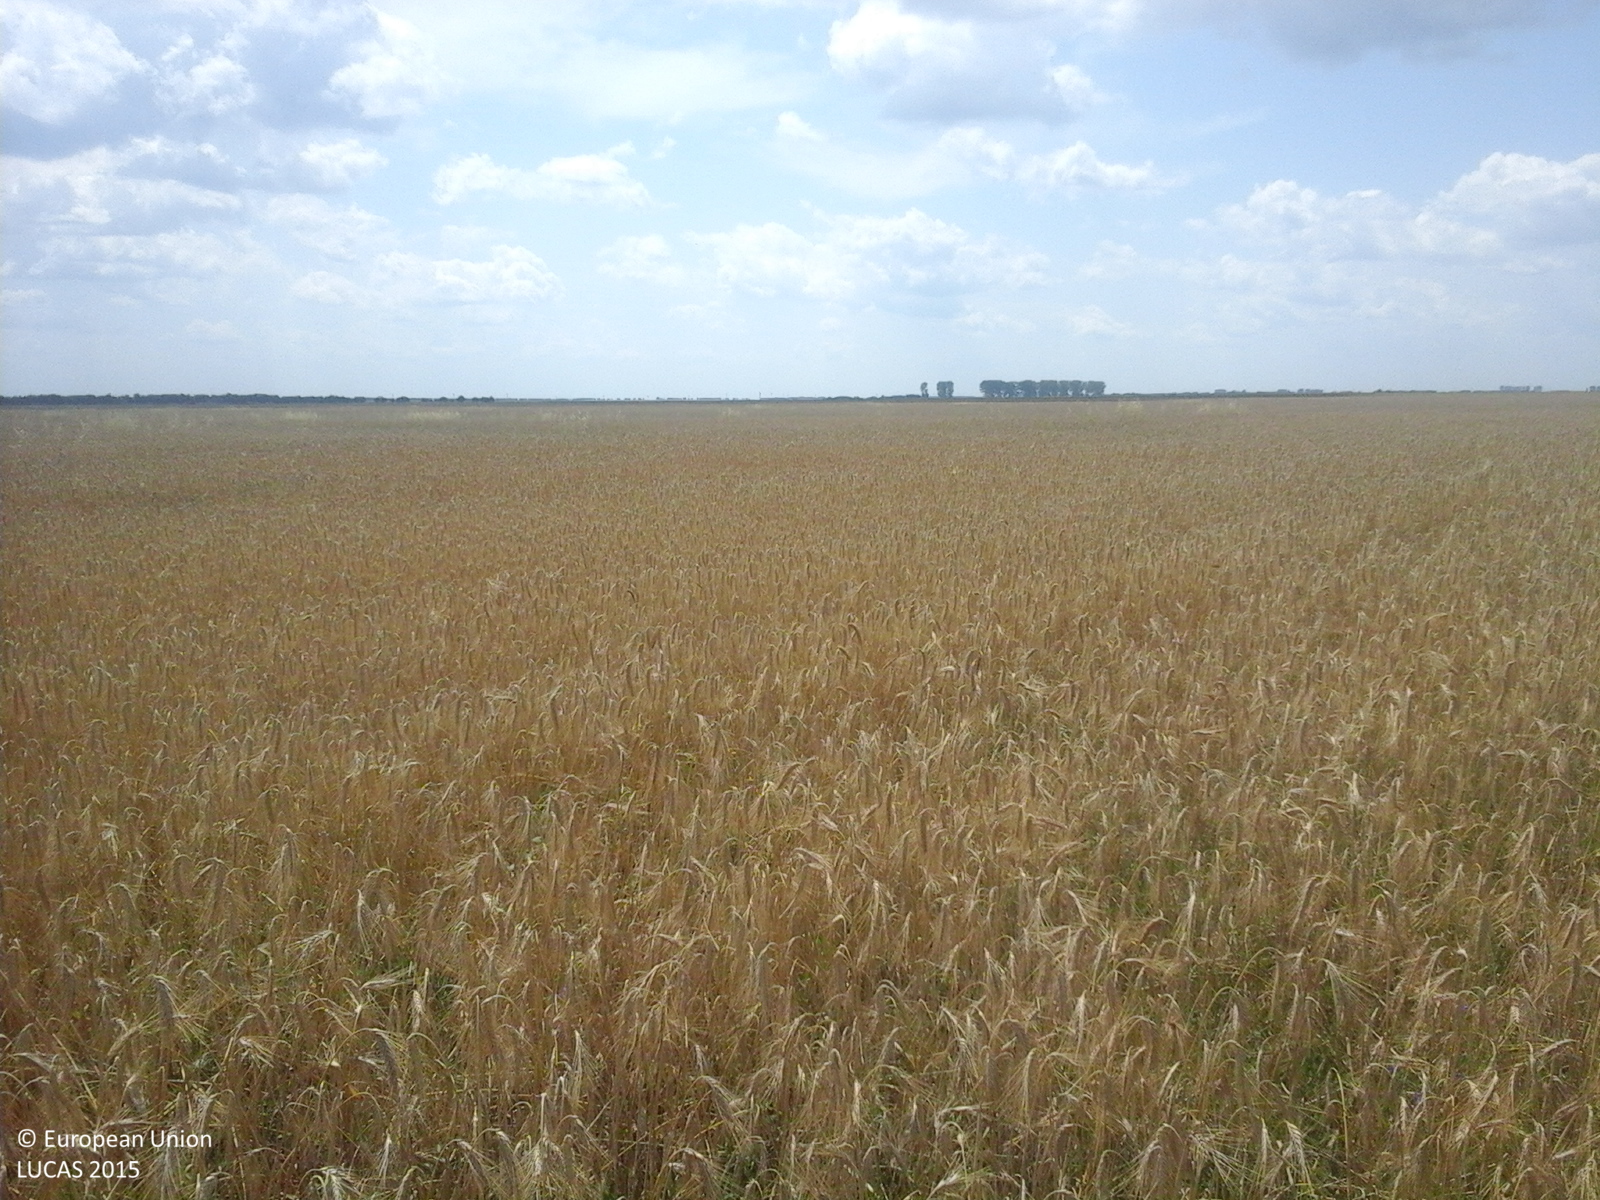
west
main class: Cropland
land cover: Common wheat
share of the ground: > 75 %
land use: Agriculture (excluding fallow land and kitchen gardens)
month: July
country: RO
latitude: 43.9109
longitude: 24.2440
